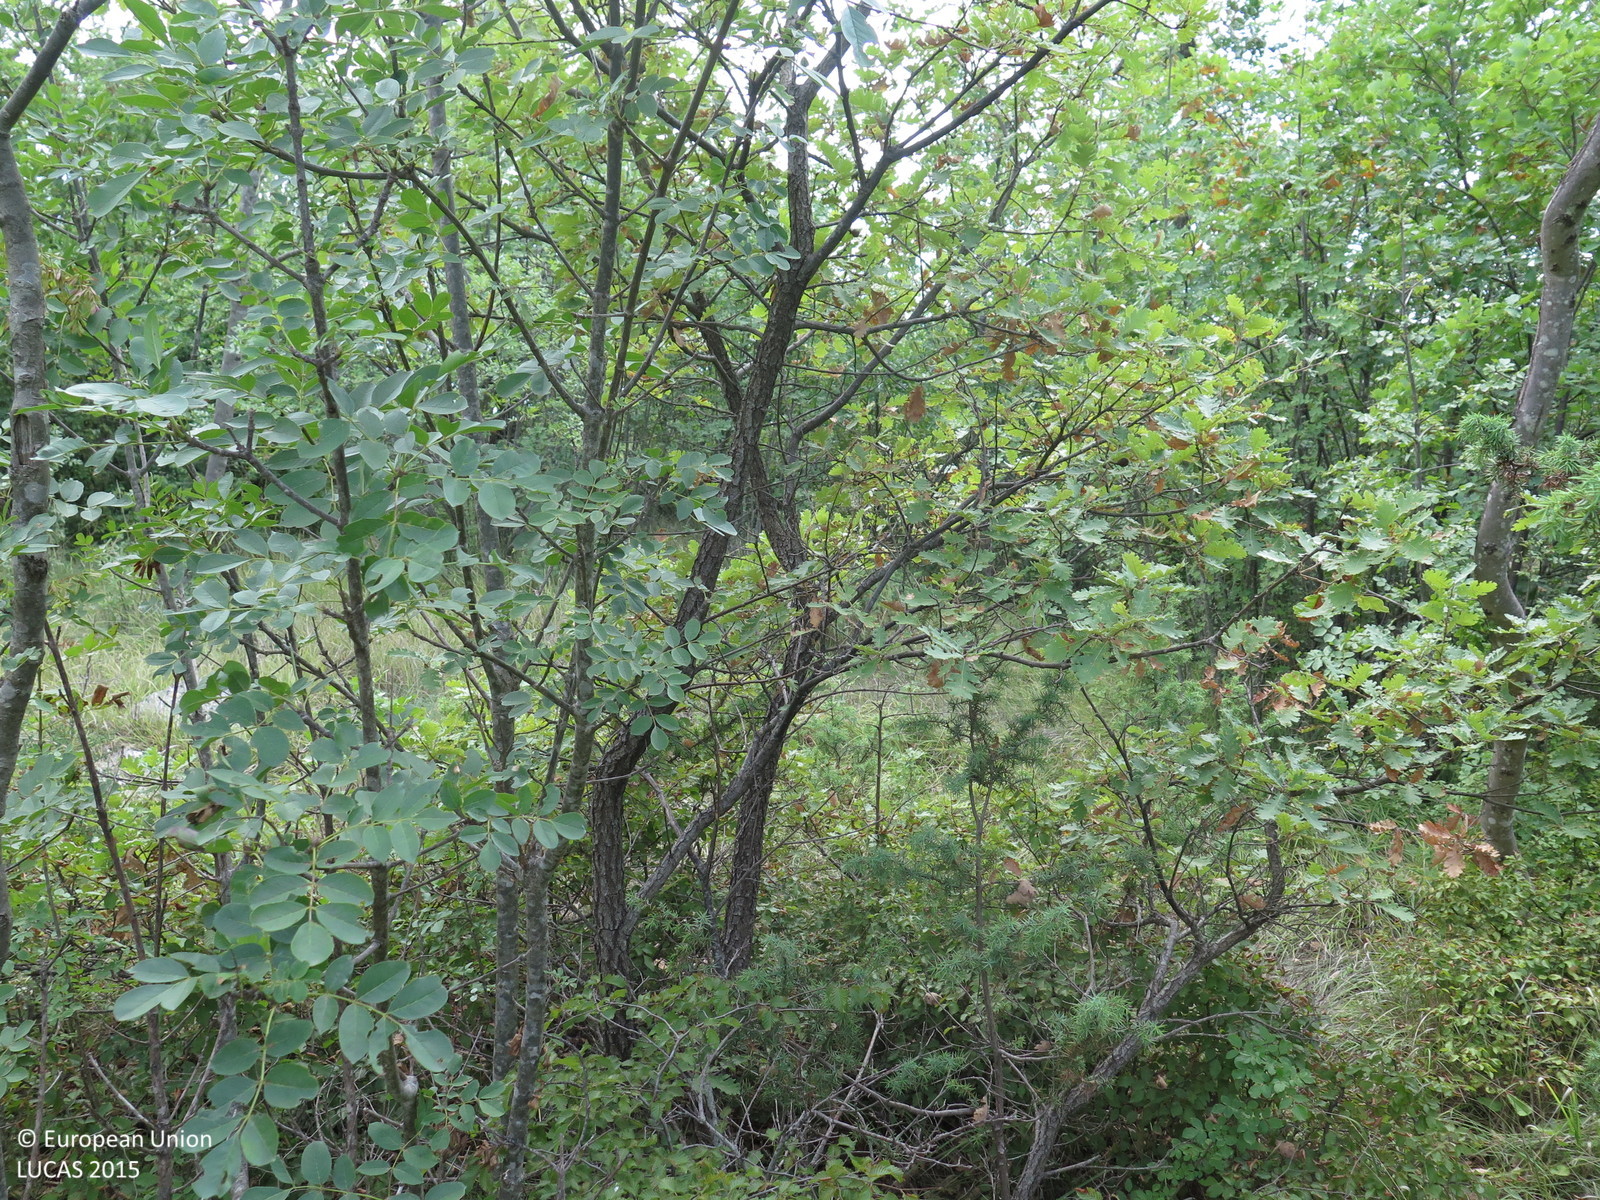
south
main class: Shrubland
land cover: Shrubland with sparse tree cover
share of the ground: > 75 %
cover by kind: shrubs 90 %, broadleaved forest trees 5 %, herbaceous plants 5 %
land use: Semi-natural and natural areas not in use
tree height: < 5 m
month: August
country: HR
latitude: 45.0463
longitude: 14.5268
